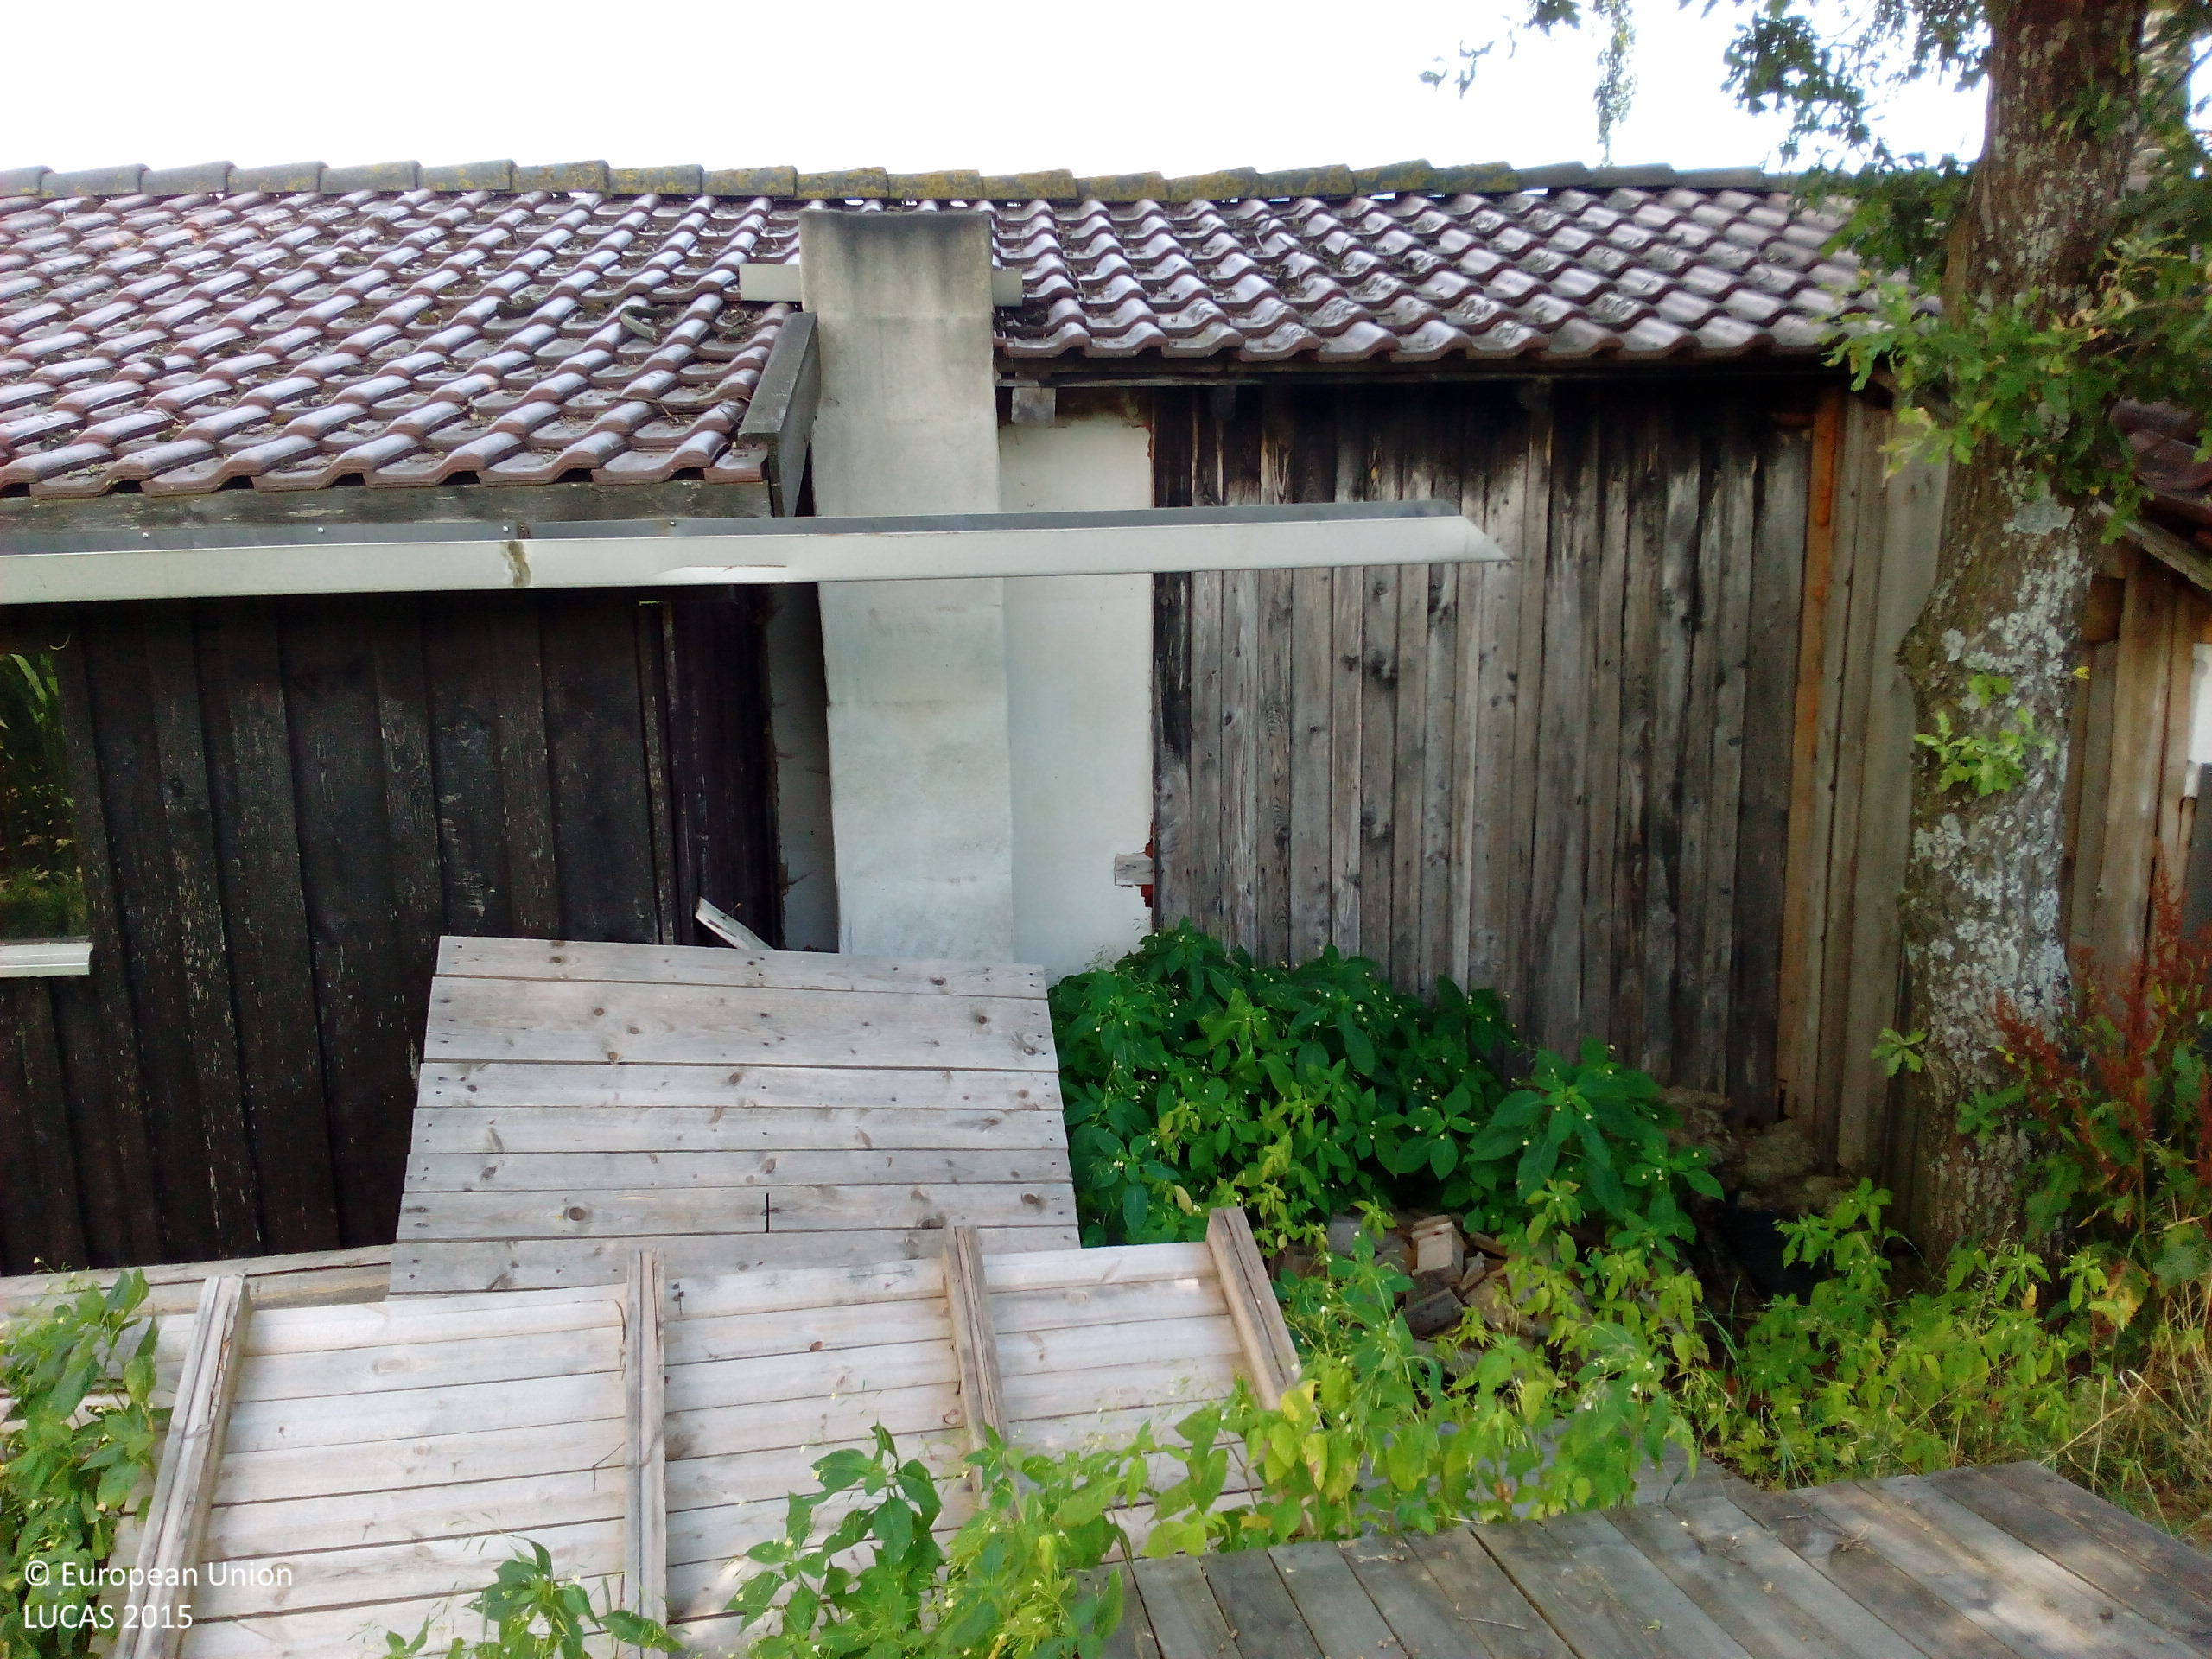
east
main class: Cropland
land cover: Maize
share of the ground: > 75 %
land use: Agriculture (excluding fallow land and kitchen gardens)
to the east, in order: Maize; Artificial constructions in urban areas; Maize; Grassland without tree/shrub cover; Common wheat; Grassland without tree/shrub cover; Spruce dominated coniferous woodland
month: July
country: DE
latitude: 48.4464
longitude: 13.2305
